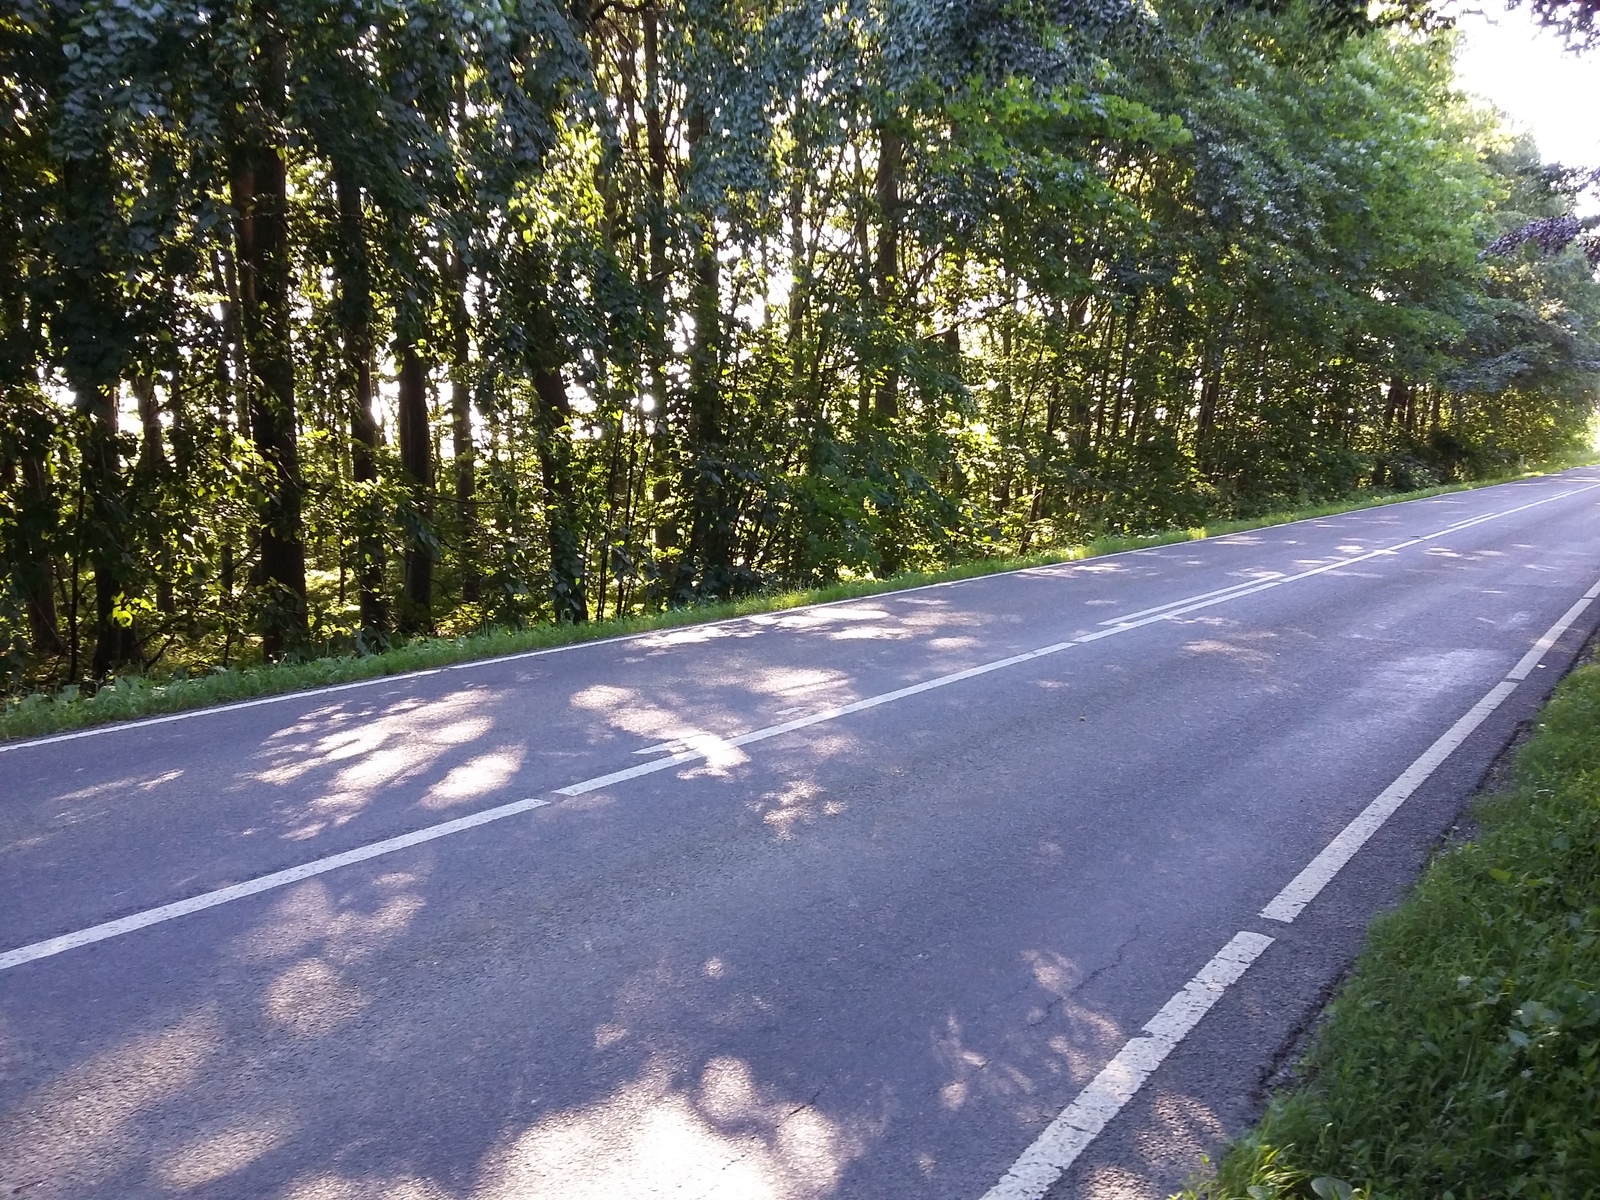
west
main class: Woodland
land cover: Broadleaved woodland
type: beech forest
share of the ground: > 75 %
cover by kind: broadleaved forest trees 90 %, herbaceous plants 10 %
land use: Forestry
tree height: > 5 m
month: July
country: DK
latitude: 55.0381
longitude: 12.0798
